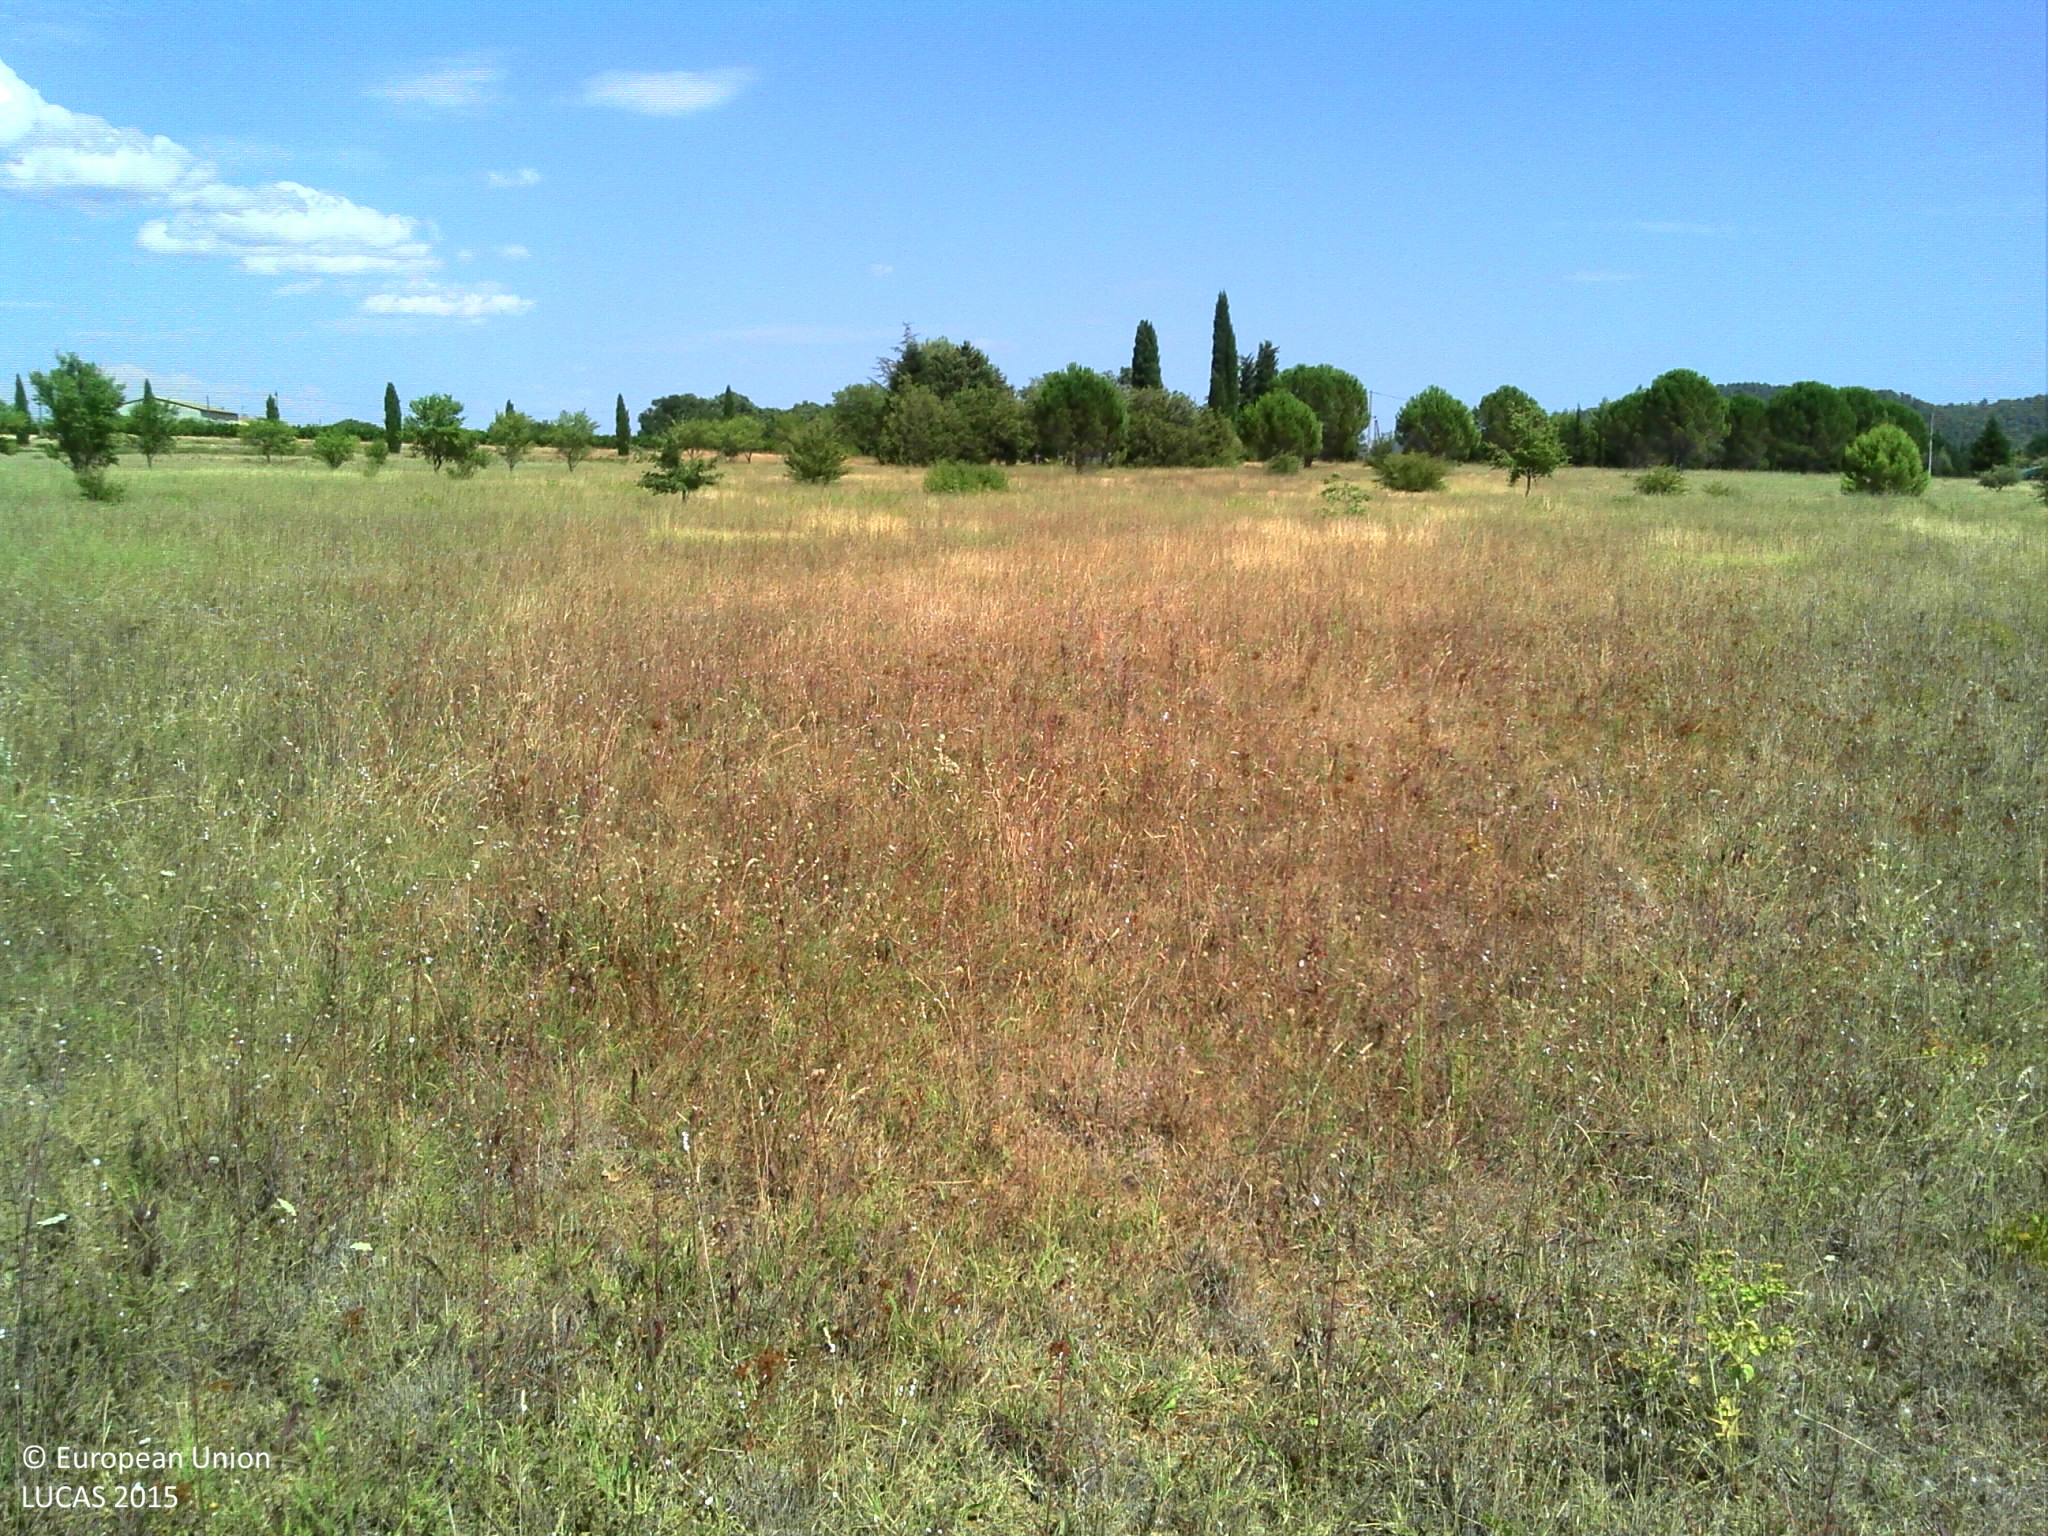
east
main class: Grassland
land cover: Grassland without tree/shrub cover
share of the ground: > 75 %
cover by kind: herbaceous plants 85 %, unconsolidated bare surface 15 %
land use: Semi-natural and natural areas not in use
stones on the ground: < 10 %
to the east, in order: Grassland without tree/shrub cover; Grassland with sparse tree/shrub cover; Lines of trees; Grass margins; Paved roads, cycling and walking lanes; Electric lines; Tracks; Vineyards
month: July
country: FR
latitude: 43.7439
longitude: 5.4270
